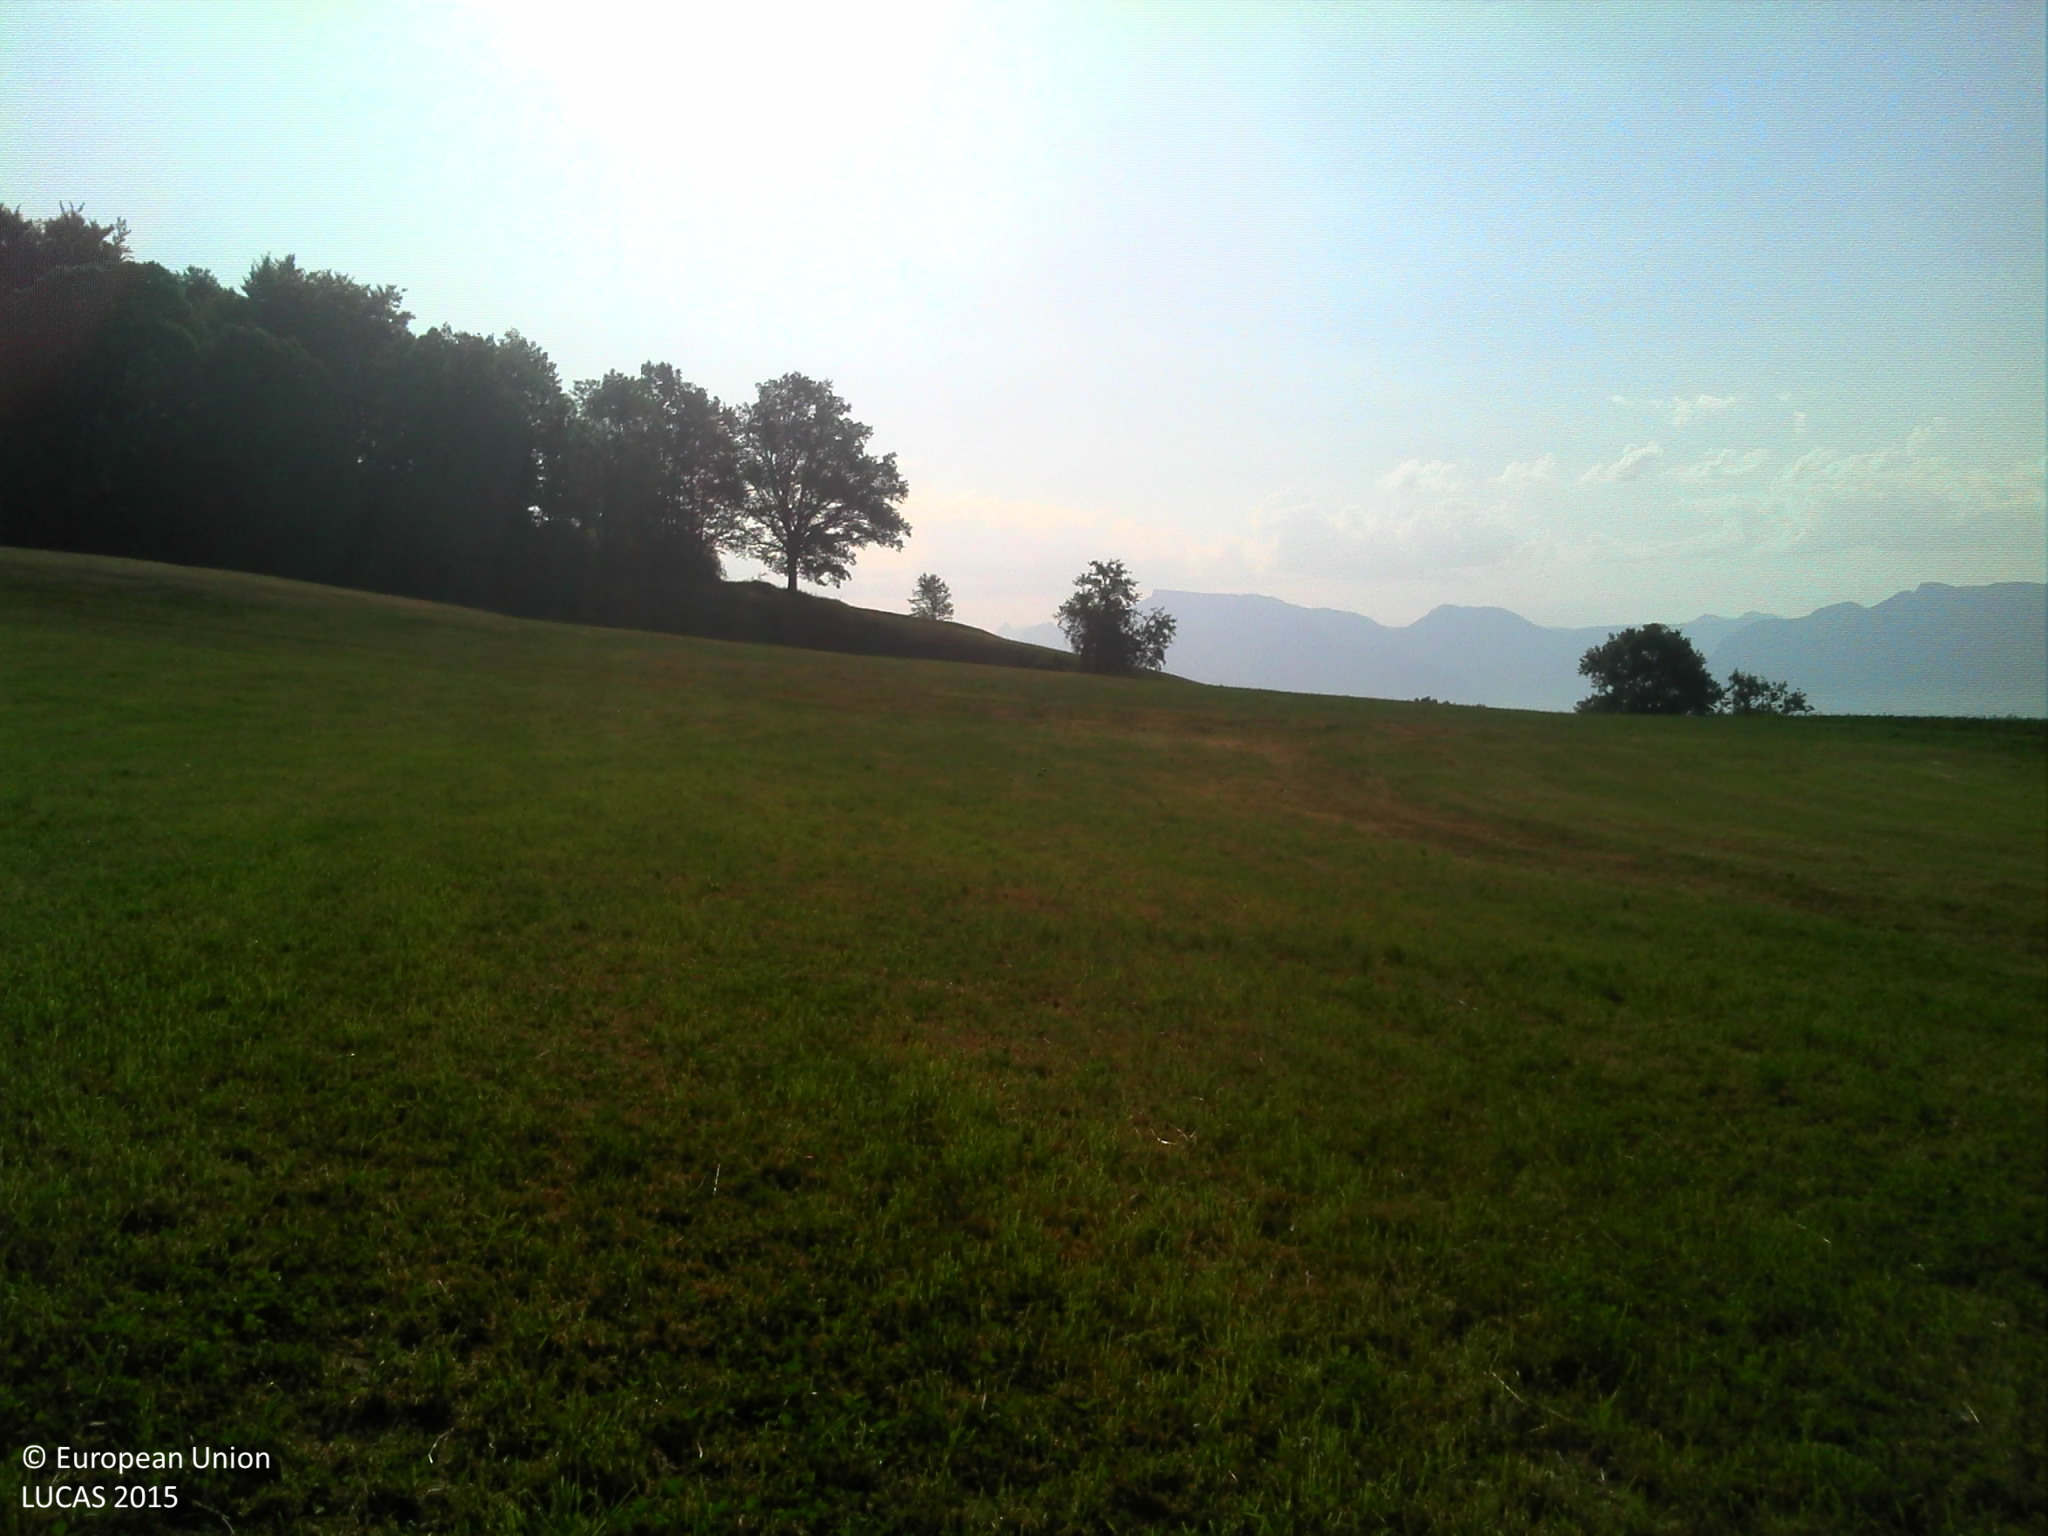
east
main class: Grassland
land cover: Grassland without tree/shrub cover
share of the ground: > 75 %
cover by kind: herbaceous plants 100 %
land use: Agriculture (excluding fallow land and kitchen gardens)
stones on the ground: < 10 %
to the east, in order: Grassland without tree/shrub cover; Fences; Grassland with sparse tree/shrub cover; Fences; Grass margins; Paved roads, cycling and walking lanes; Grass margins; Grassland without tree/shrub cover
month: July
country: FR
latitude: 46.0282
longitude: 6.1151
